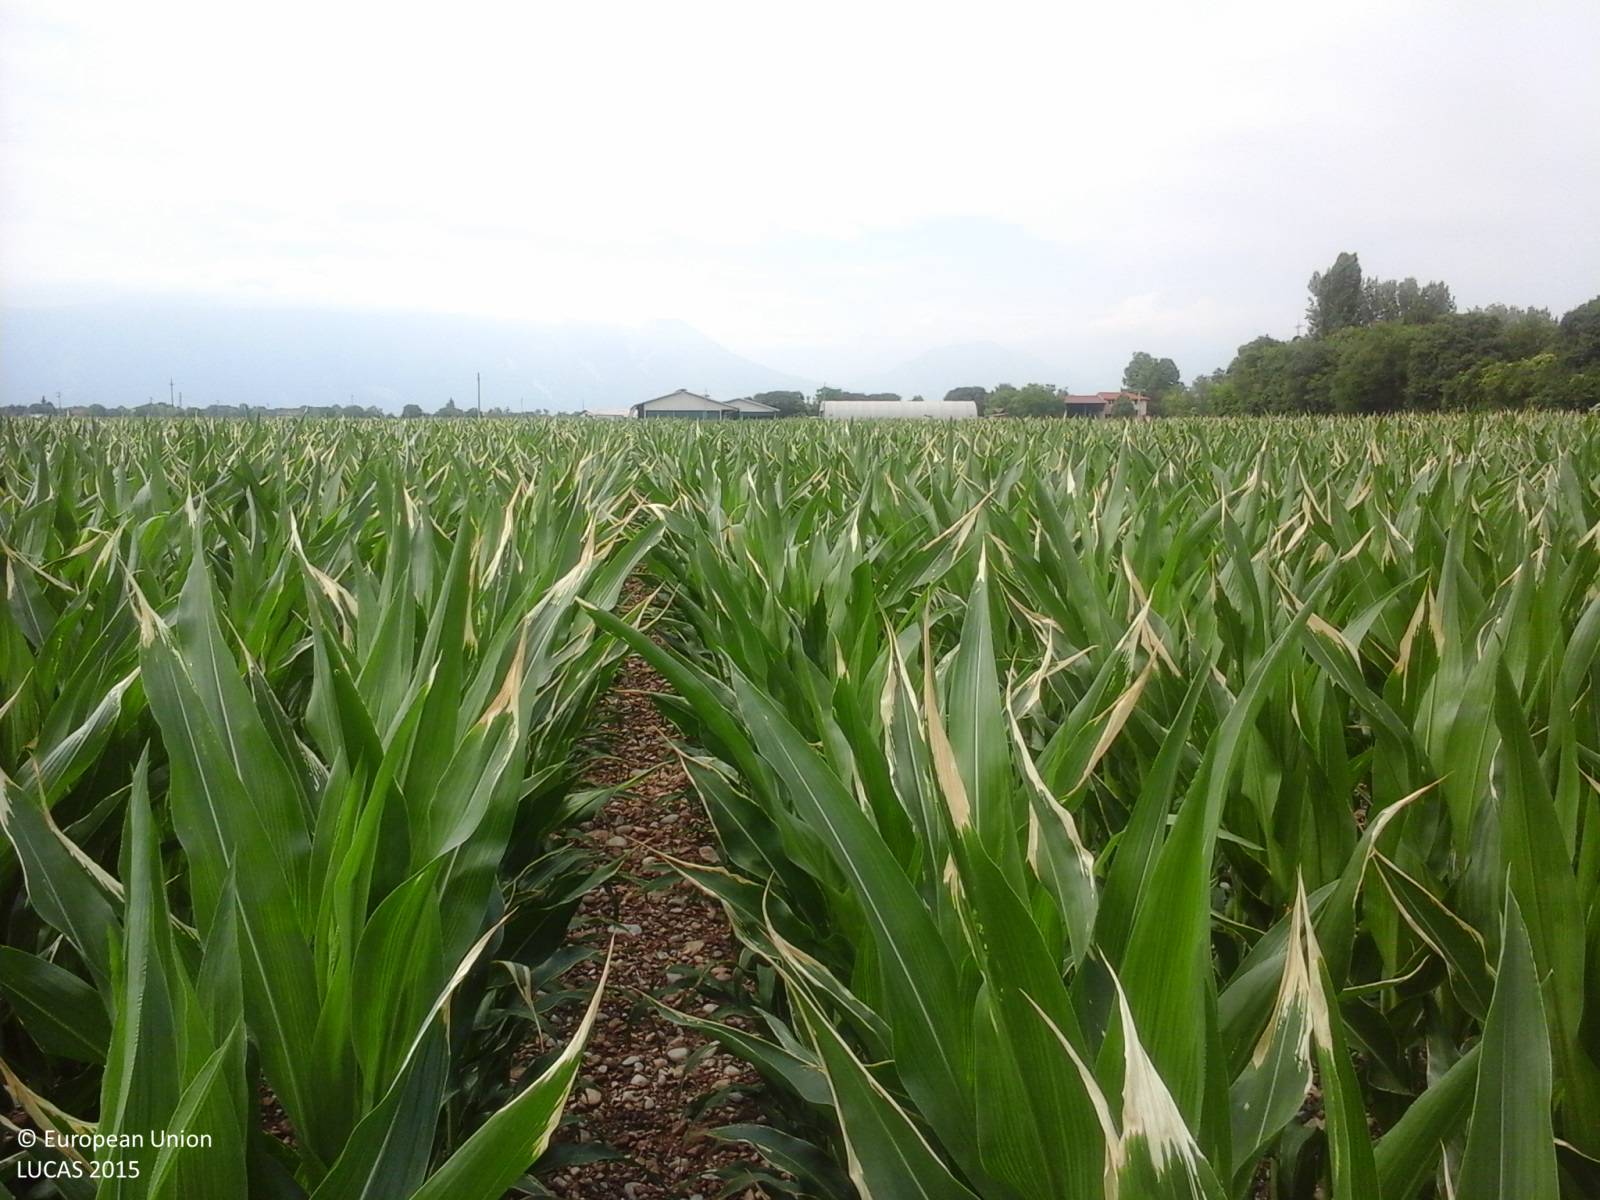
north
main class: Cropland
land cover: Maize
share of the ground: > 75 %
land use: Agriculture (excluding fallow land and kitchen gardens)
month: June
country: IT
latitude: 46.0108
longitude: 12.6959
